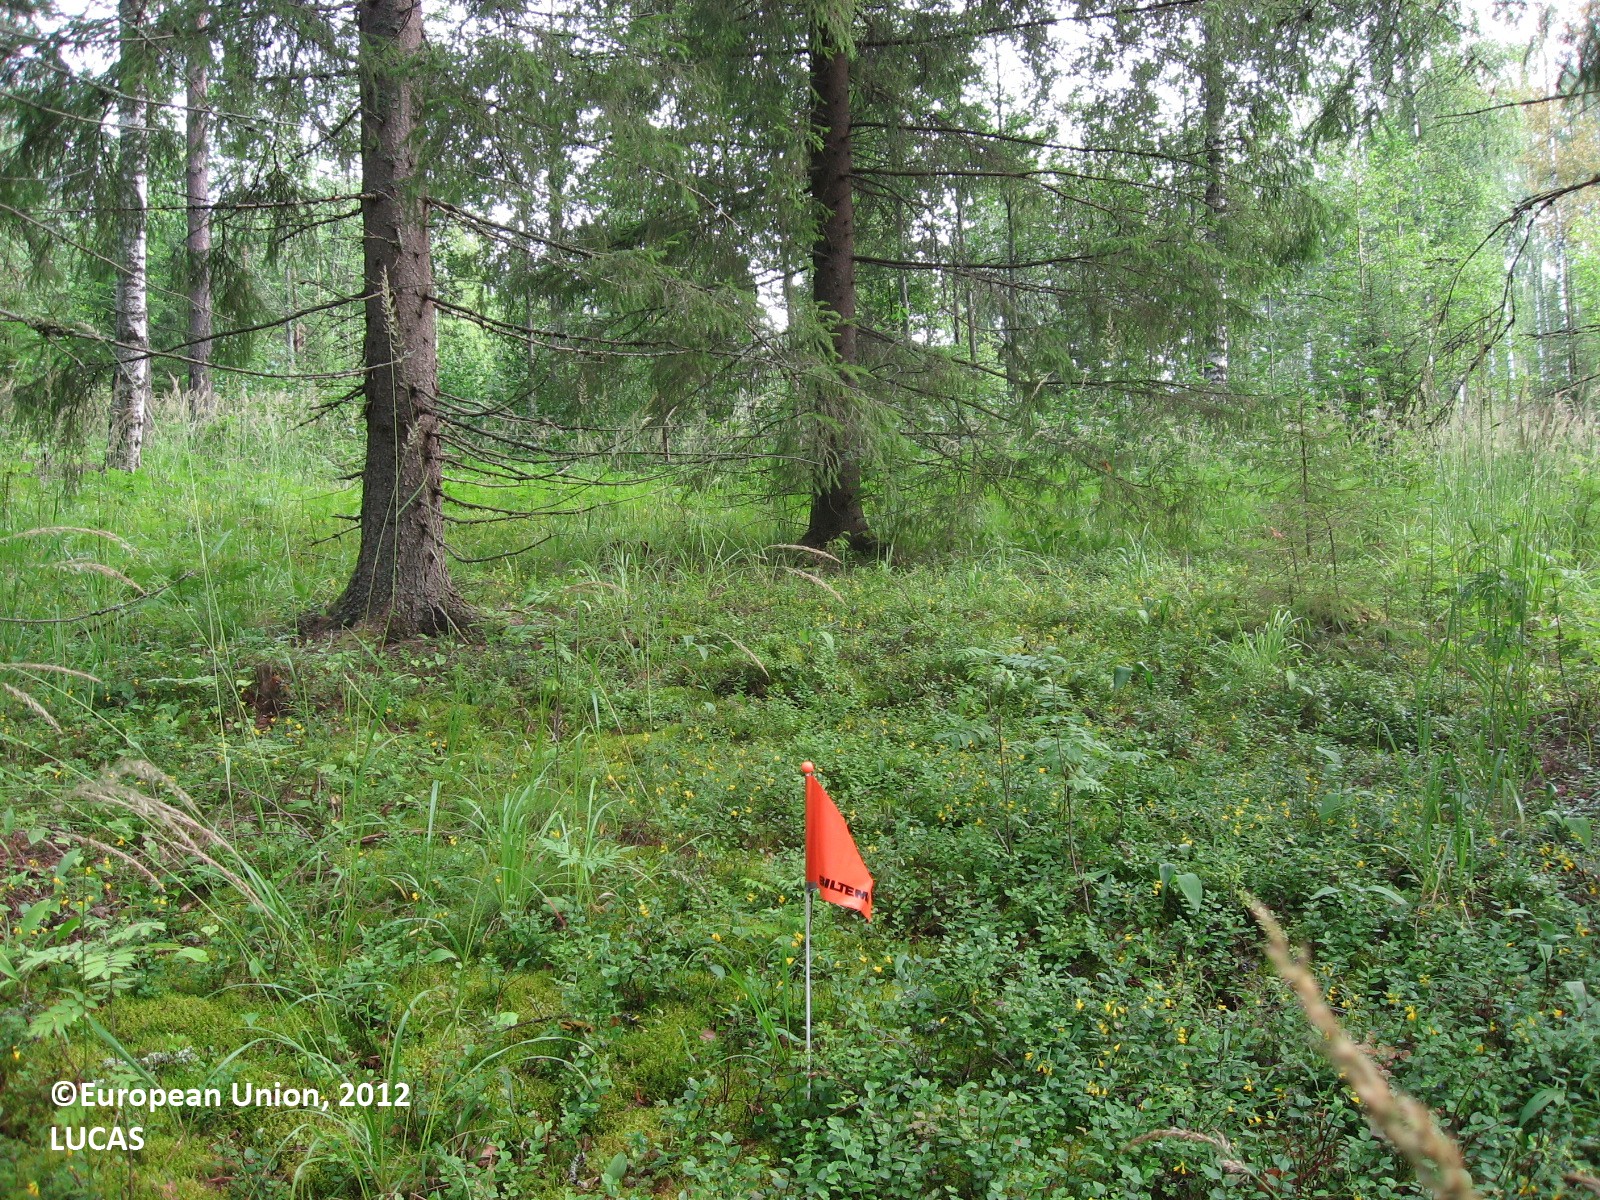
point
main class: Woodland
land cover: Spruce dominated coniferous woodland
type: boreal forest
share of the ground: 25 - 50 %
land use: Forestry
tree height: > 5 m
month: July
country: FI
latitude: 61.2447
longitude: 26.5301
